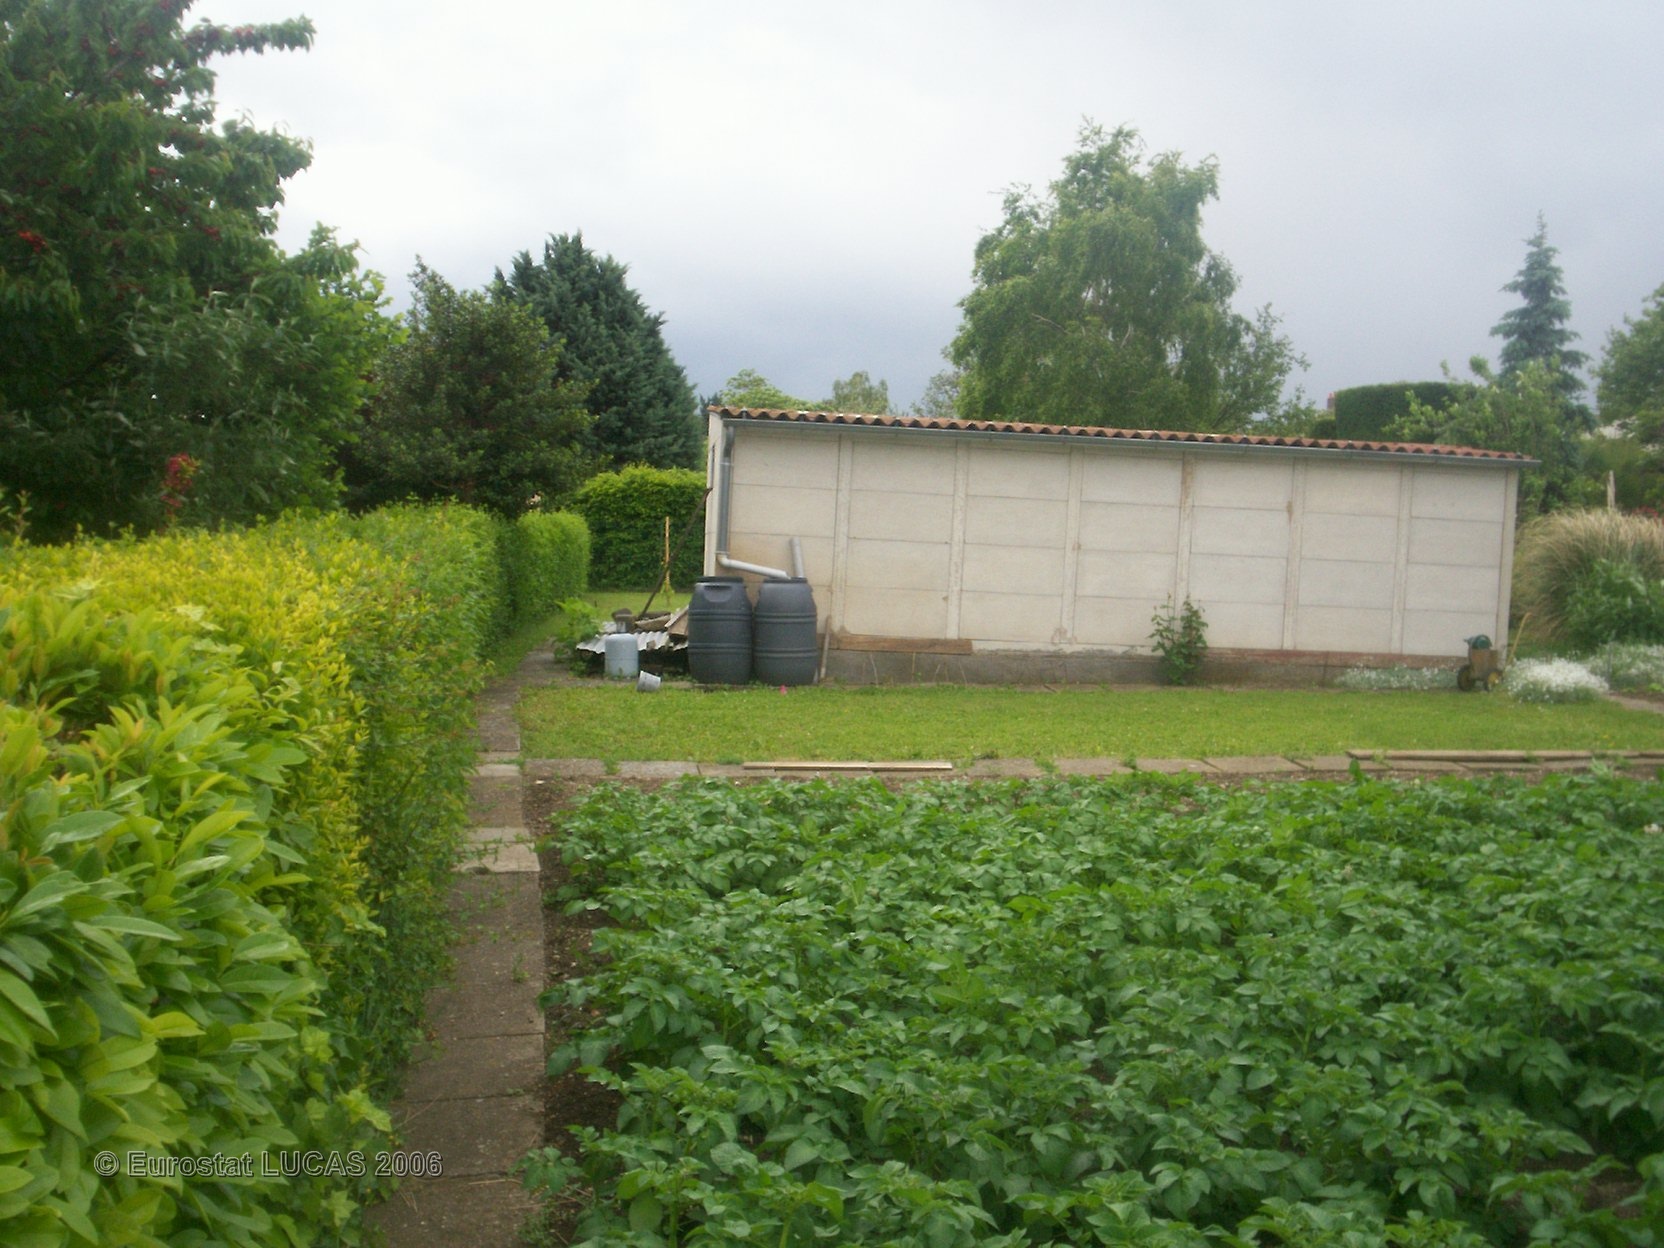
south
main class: Cropland
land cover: Other fresh vegetables
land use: Kitchen garden
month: May
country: FR
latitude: 45.7372
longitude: 3.2016
